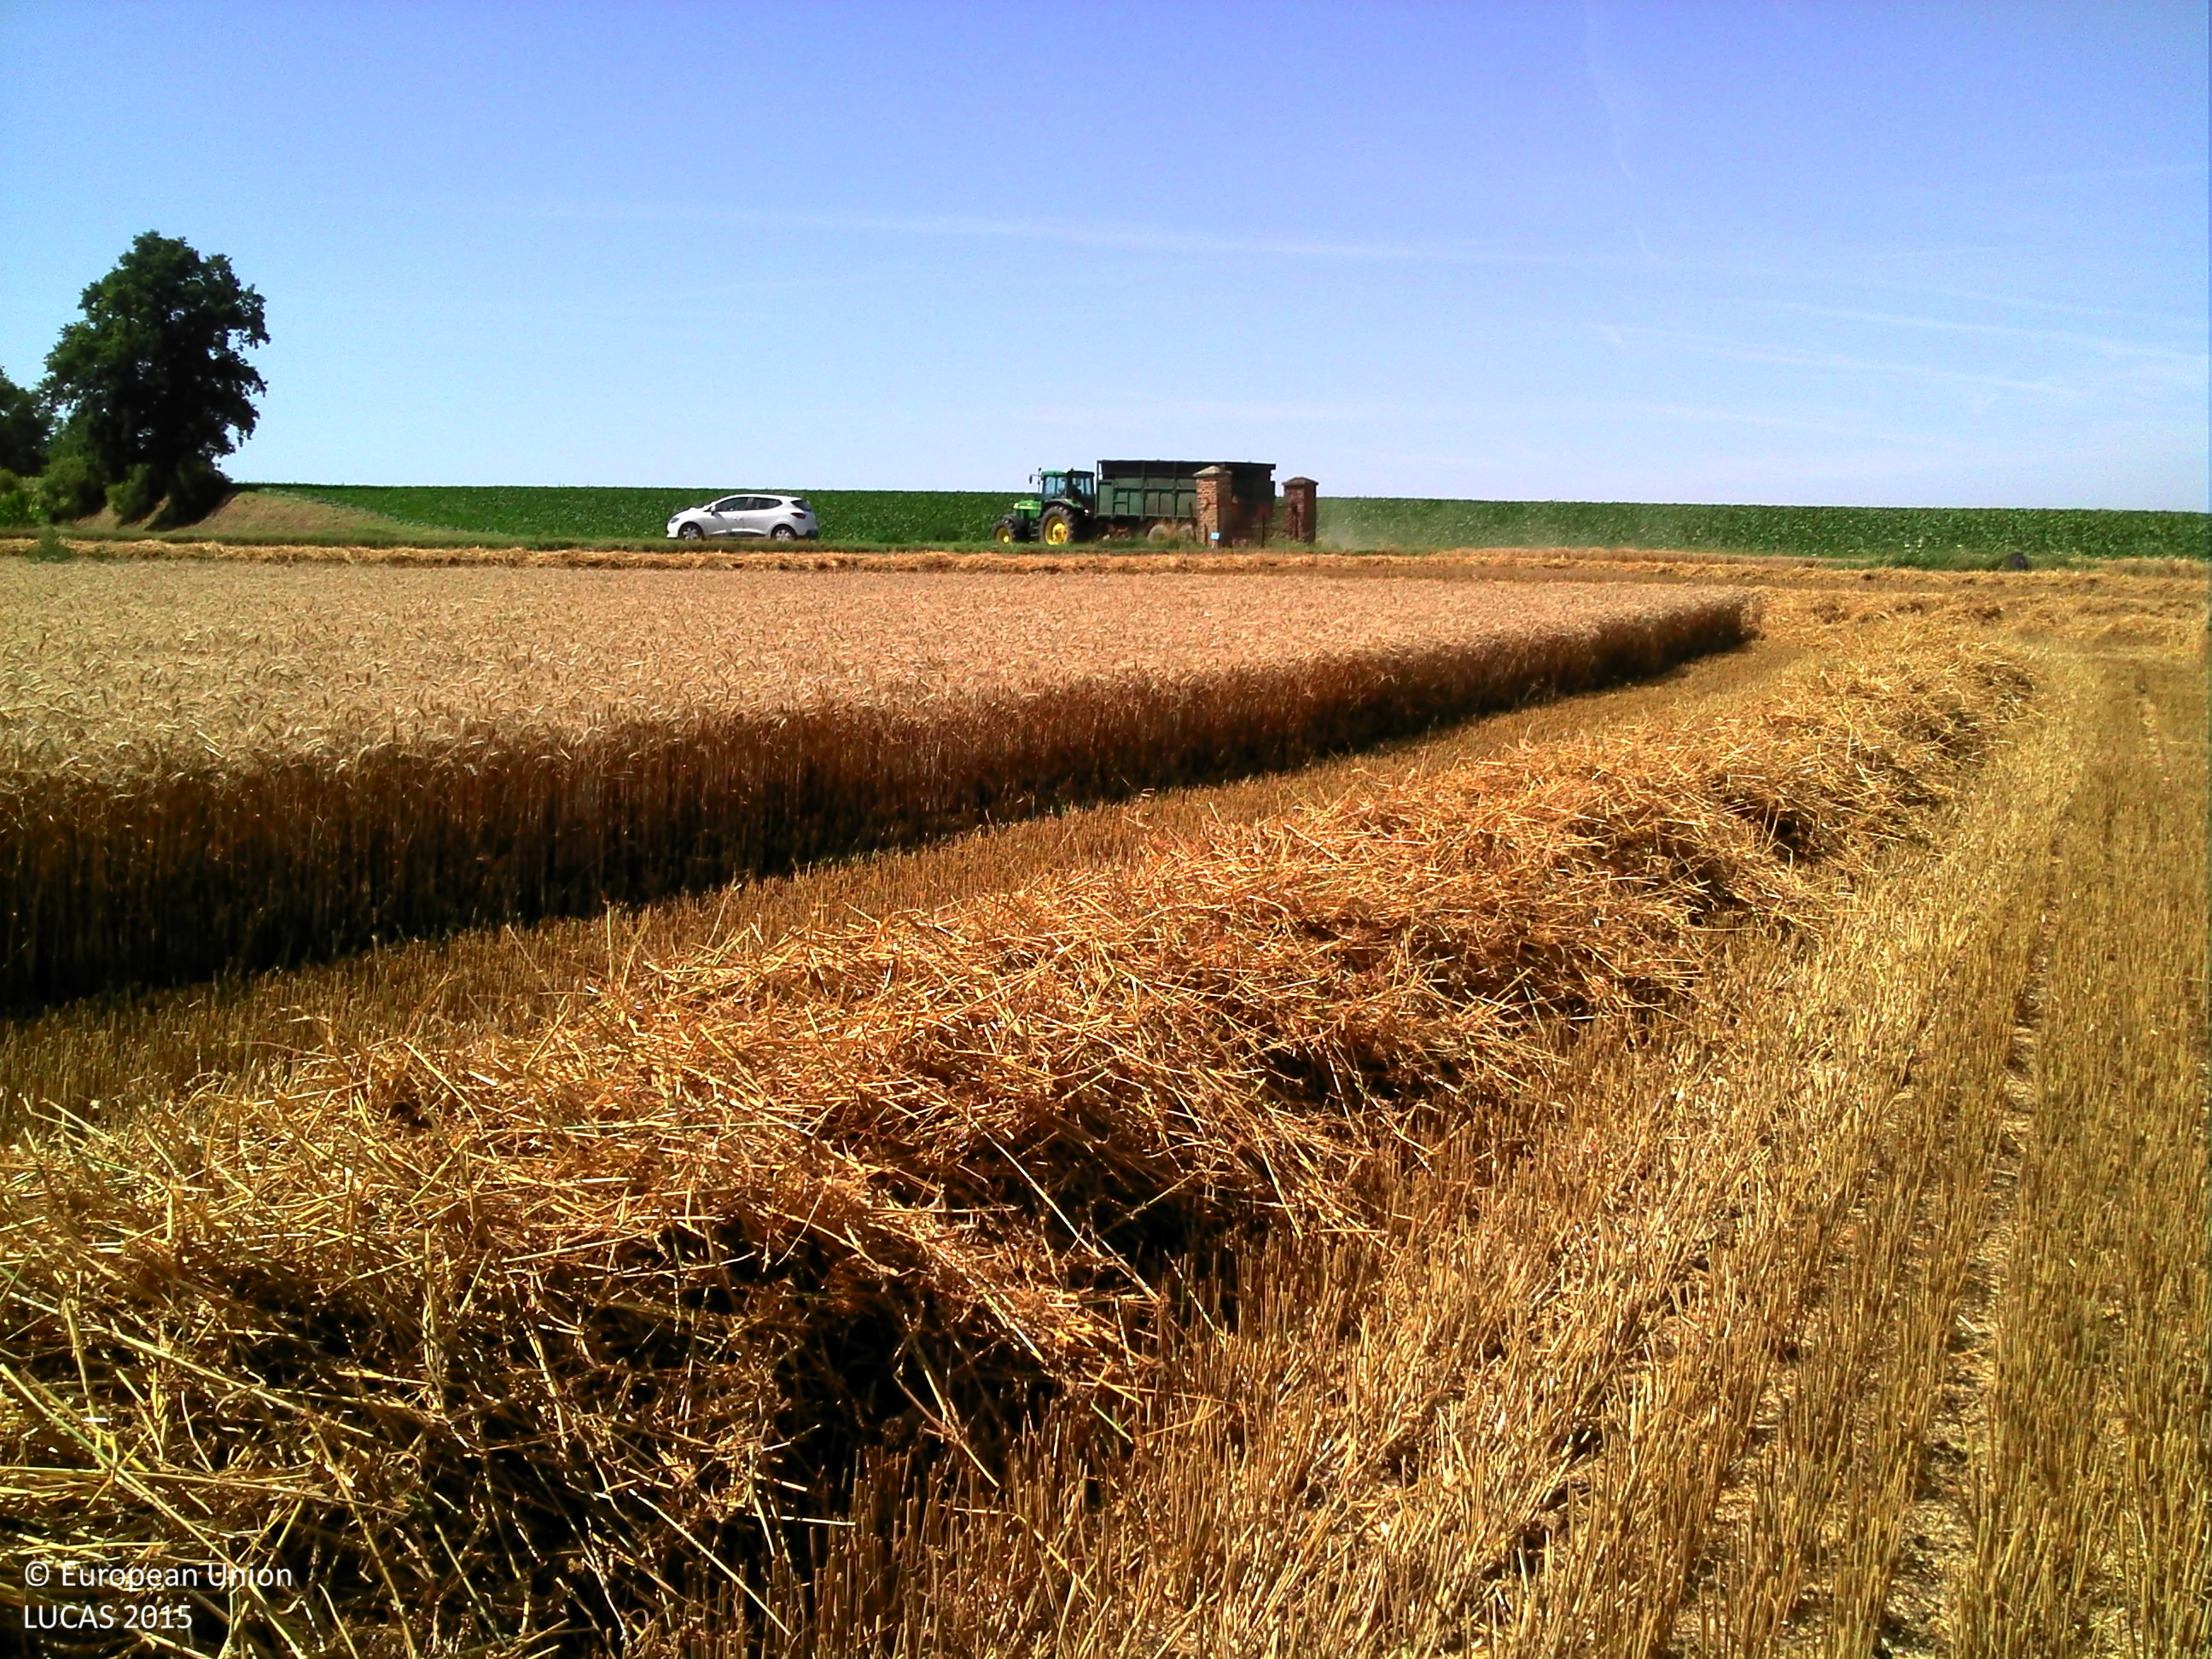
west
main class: Cropland
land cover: Common wheat
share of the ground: > 75 %
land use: Agriculture (excluding fallow land and kitchen gardens)
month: August
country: BE
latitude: 50.7350
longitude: 5.2795
